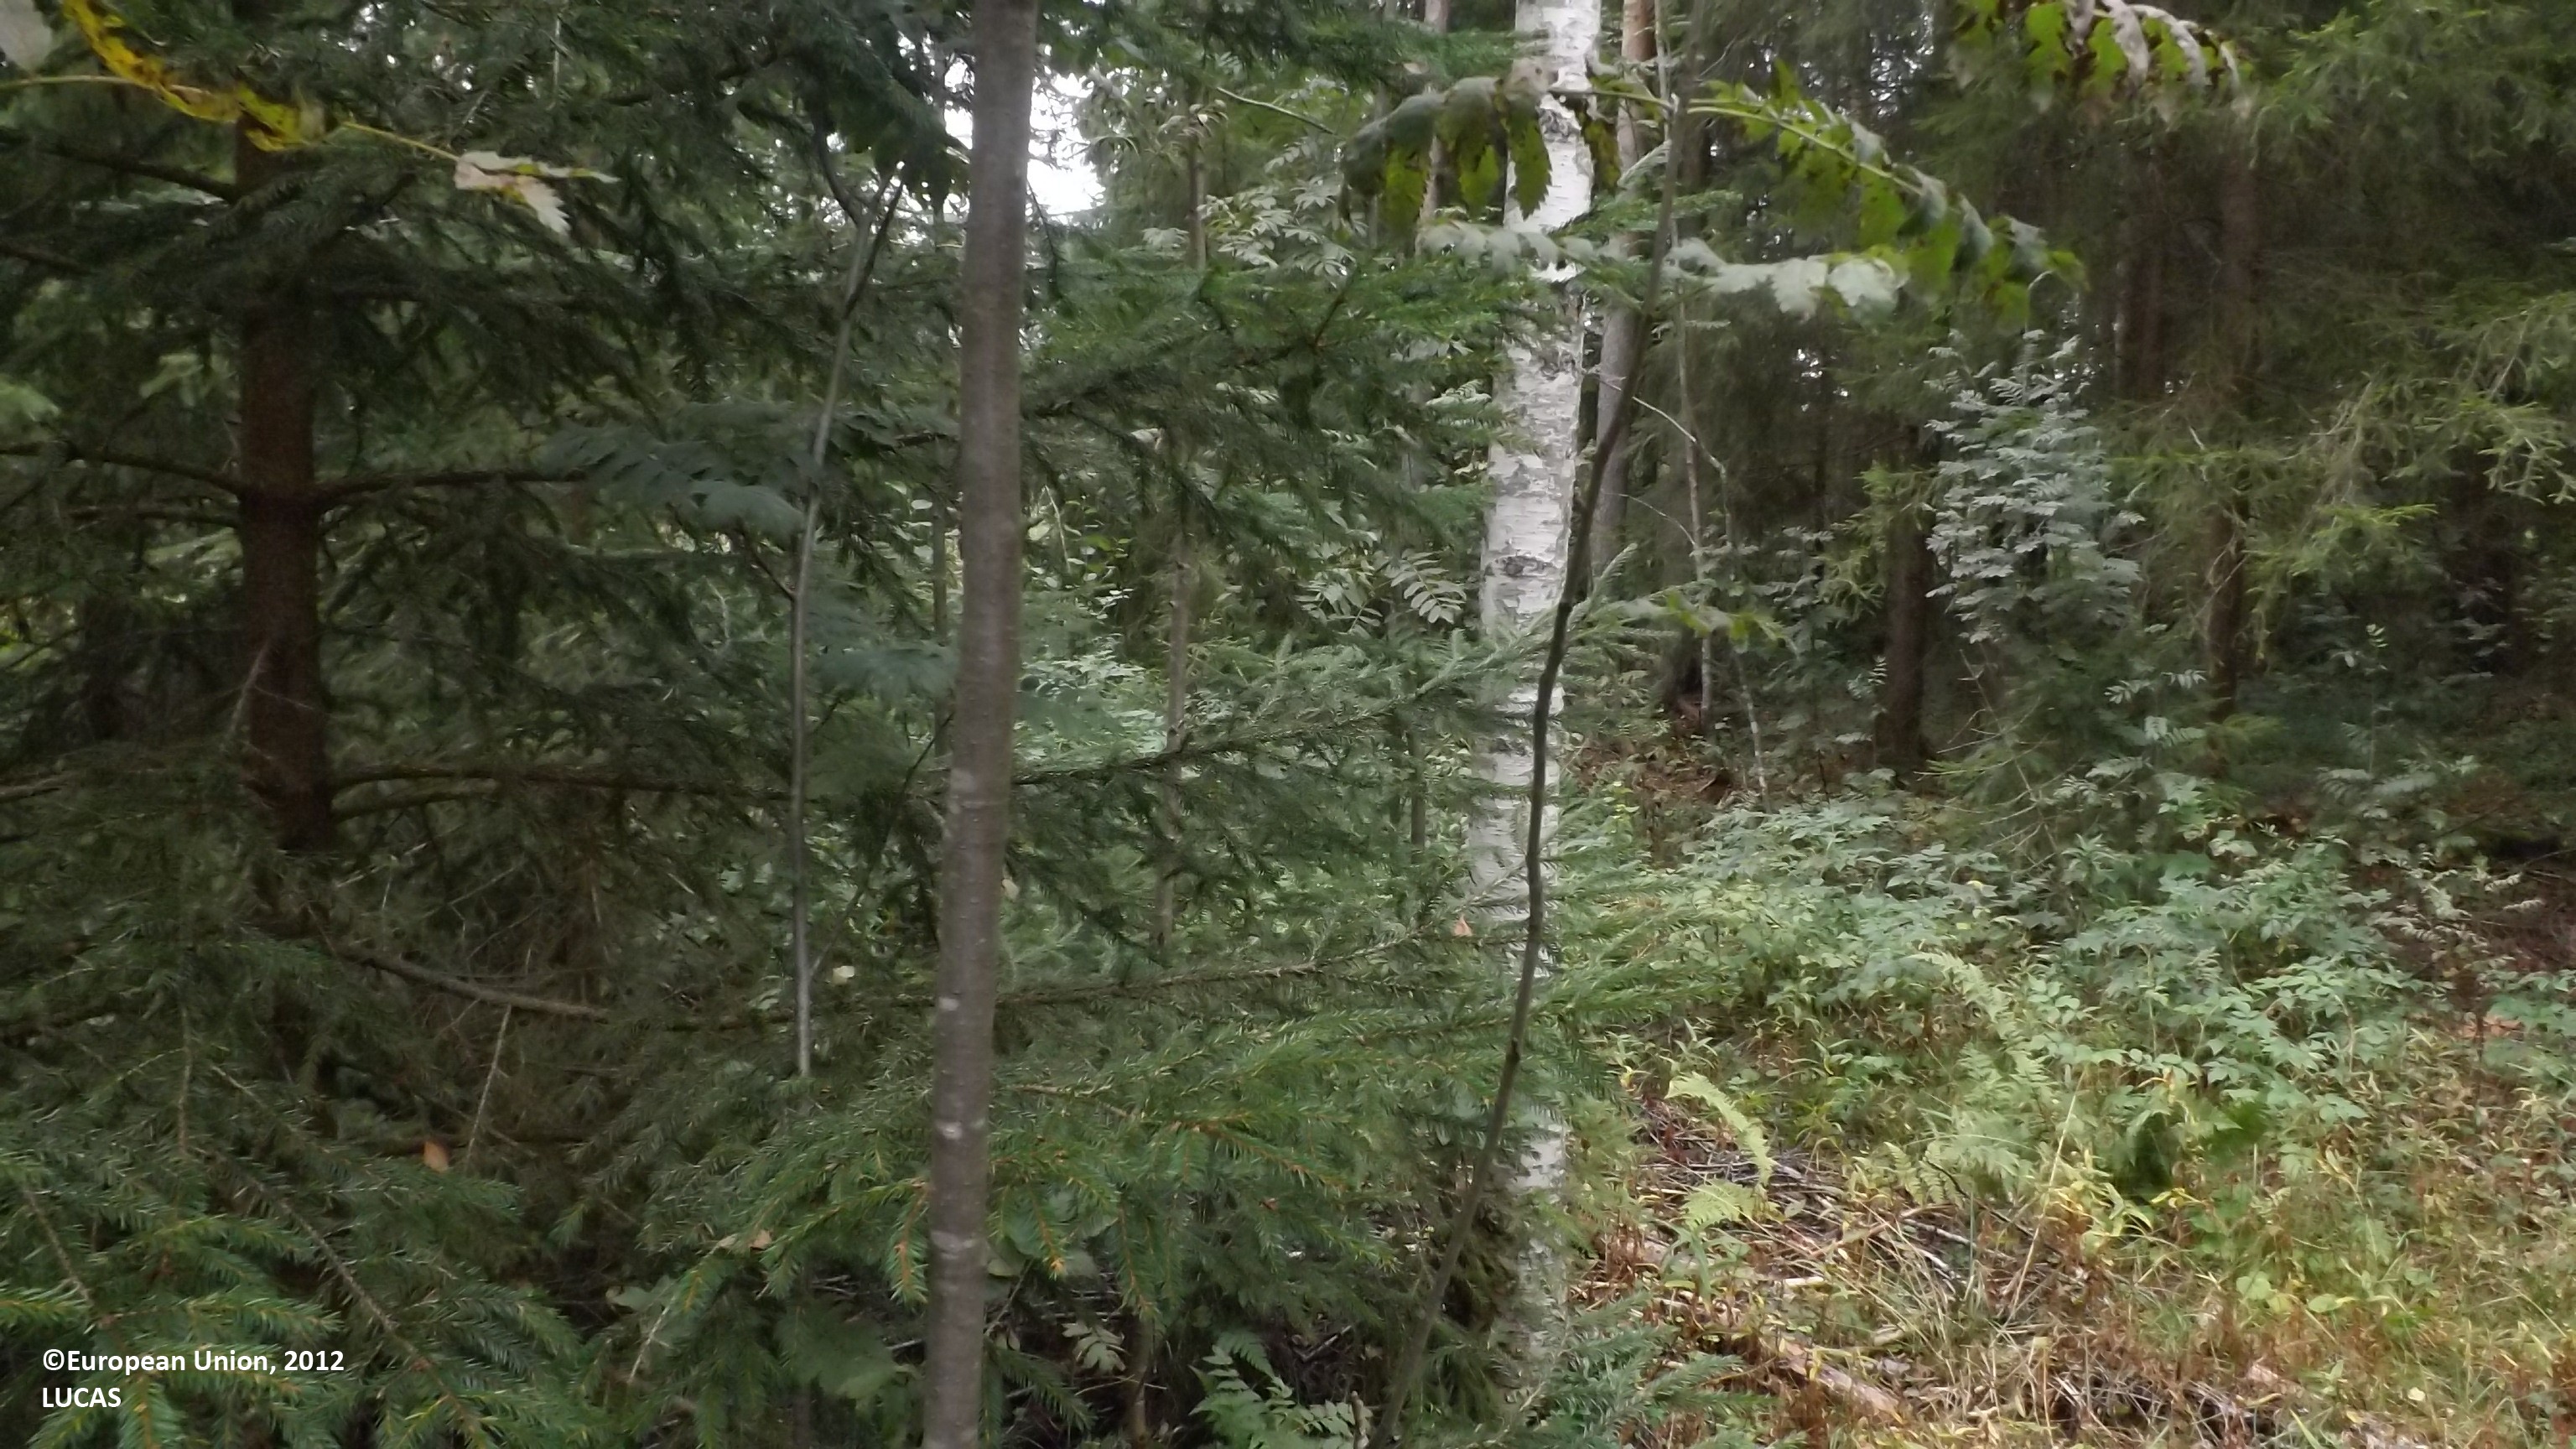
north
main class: Woodland
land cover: Other mixed woodland
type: boreal forest
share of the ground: 50 - 75 %
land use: Forestry
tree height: > 5 m
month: August
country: FI
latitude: 63.7731
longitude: 23.3824
